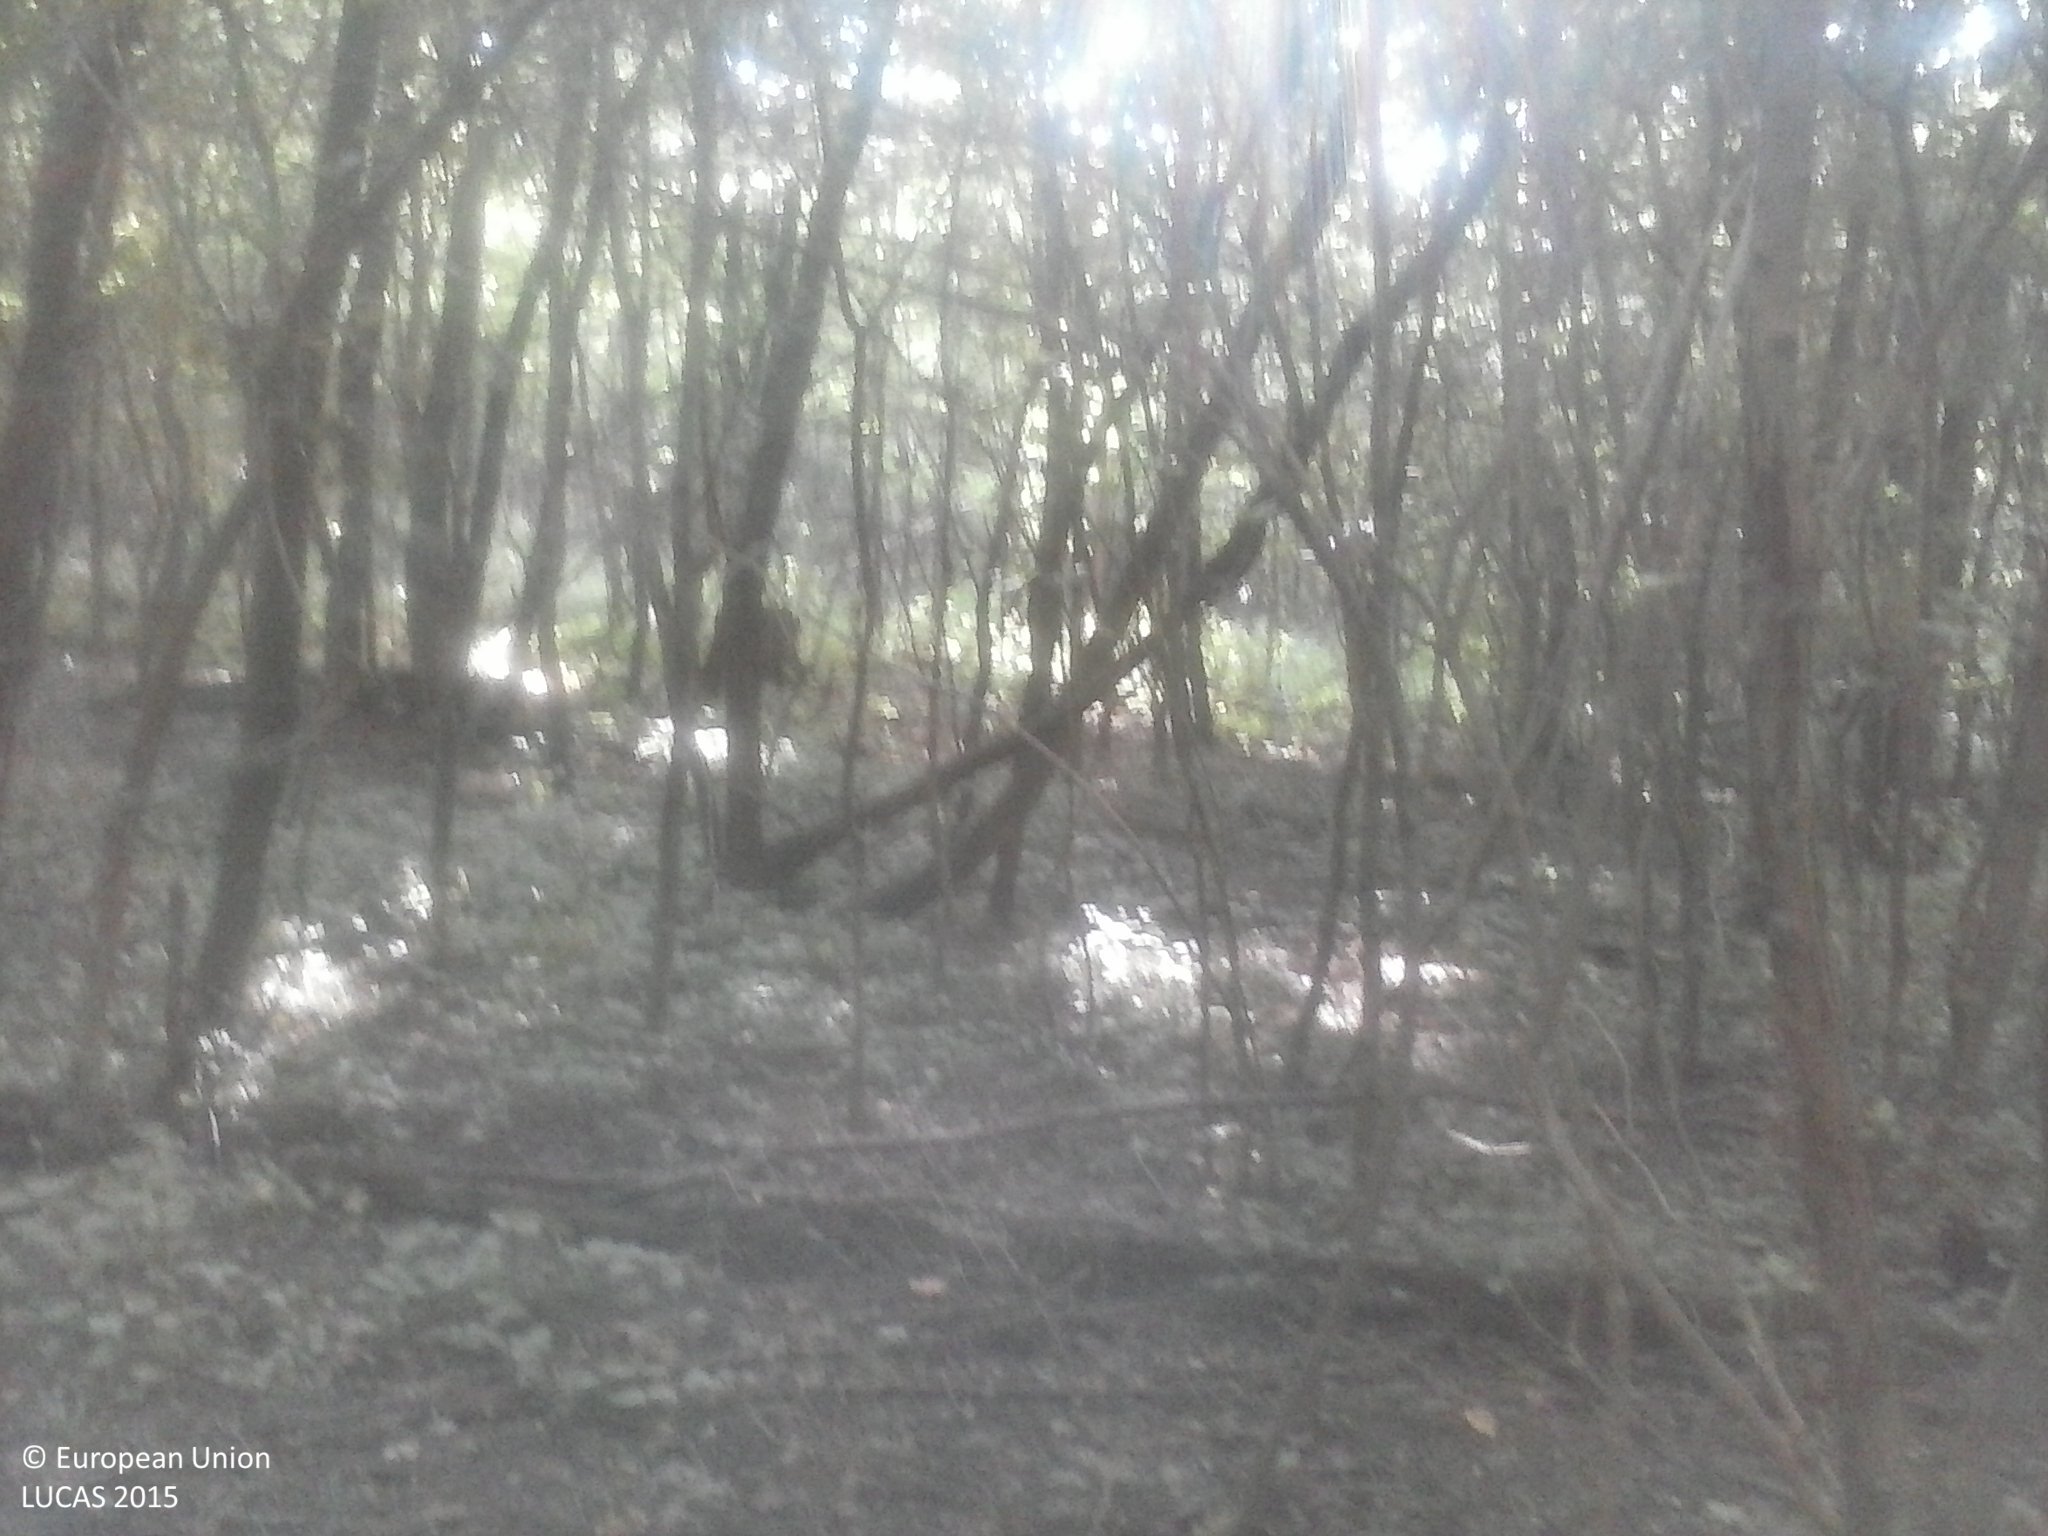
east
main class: Woodland
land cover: Broadleaved woodland
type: mesophytic deciduous forest
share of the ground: > 75 %
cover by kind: broadleaved forest trees 90 %, shrubs 5 %, herbaceous plants 5 %
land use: Semi-natural and natural areas not in use
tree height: > 5 m
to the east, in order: Broadleaved woodland; Grassland without tree/shrub cover
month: August
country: HU
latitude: 46.2093
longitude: 17.8212
